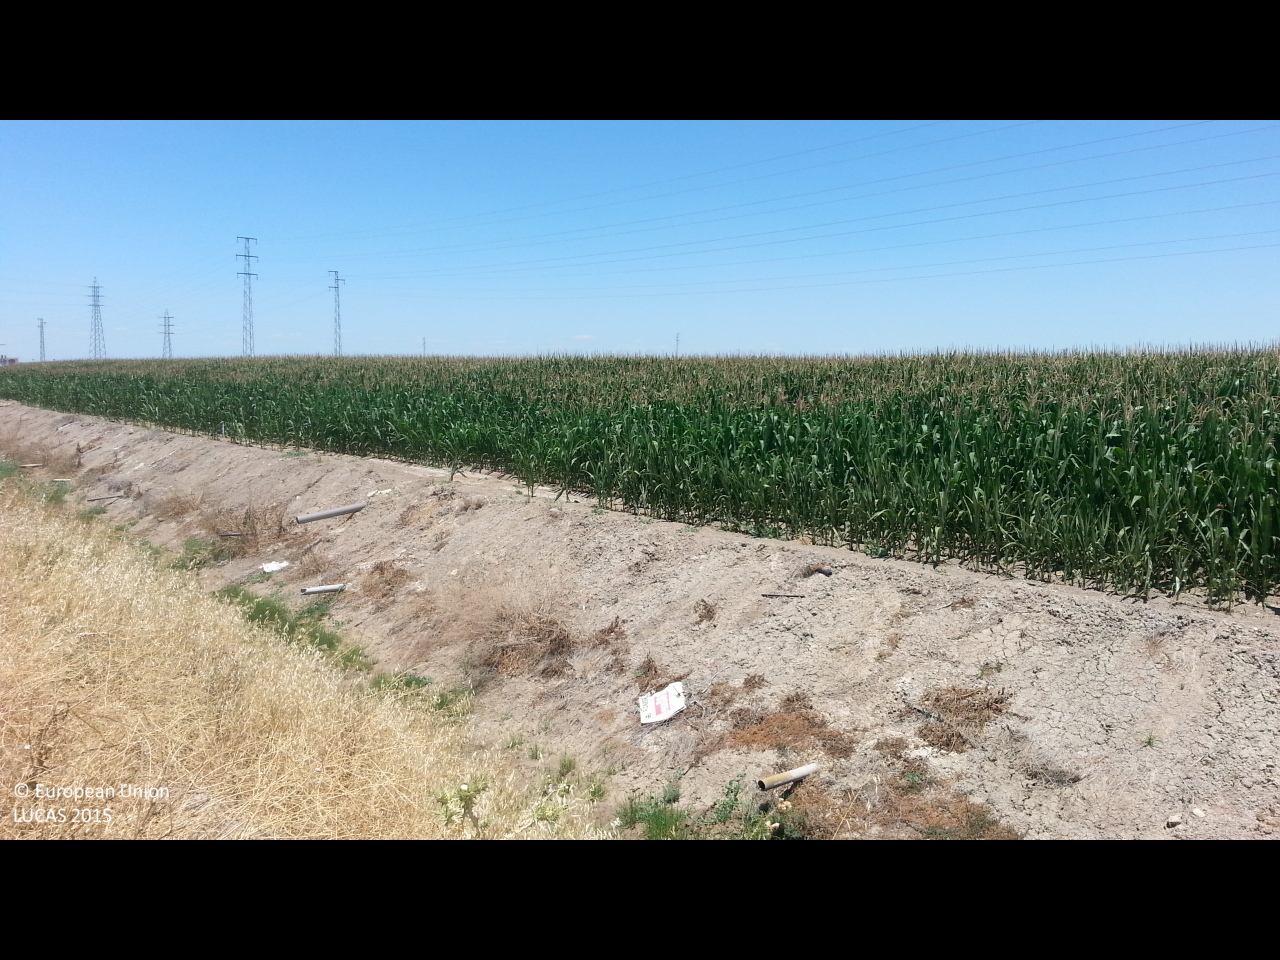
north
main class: Cropland
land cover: Maize
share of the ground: > 75 %
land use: Agriculture (excluding fallow land and kitchen gardens)
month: June
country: ES
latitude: 36.9620
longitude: -6.0663
